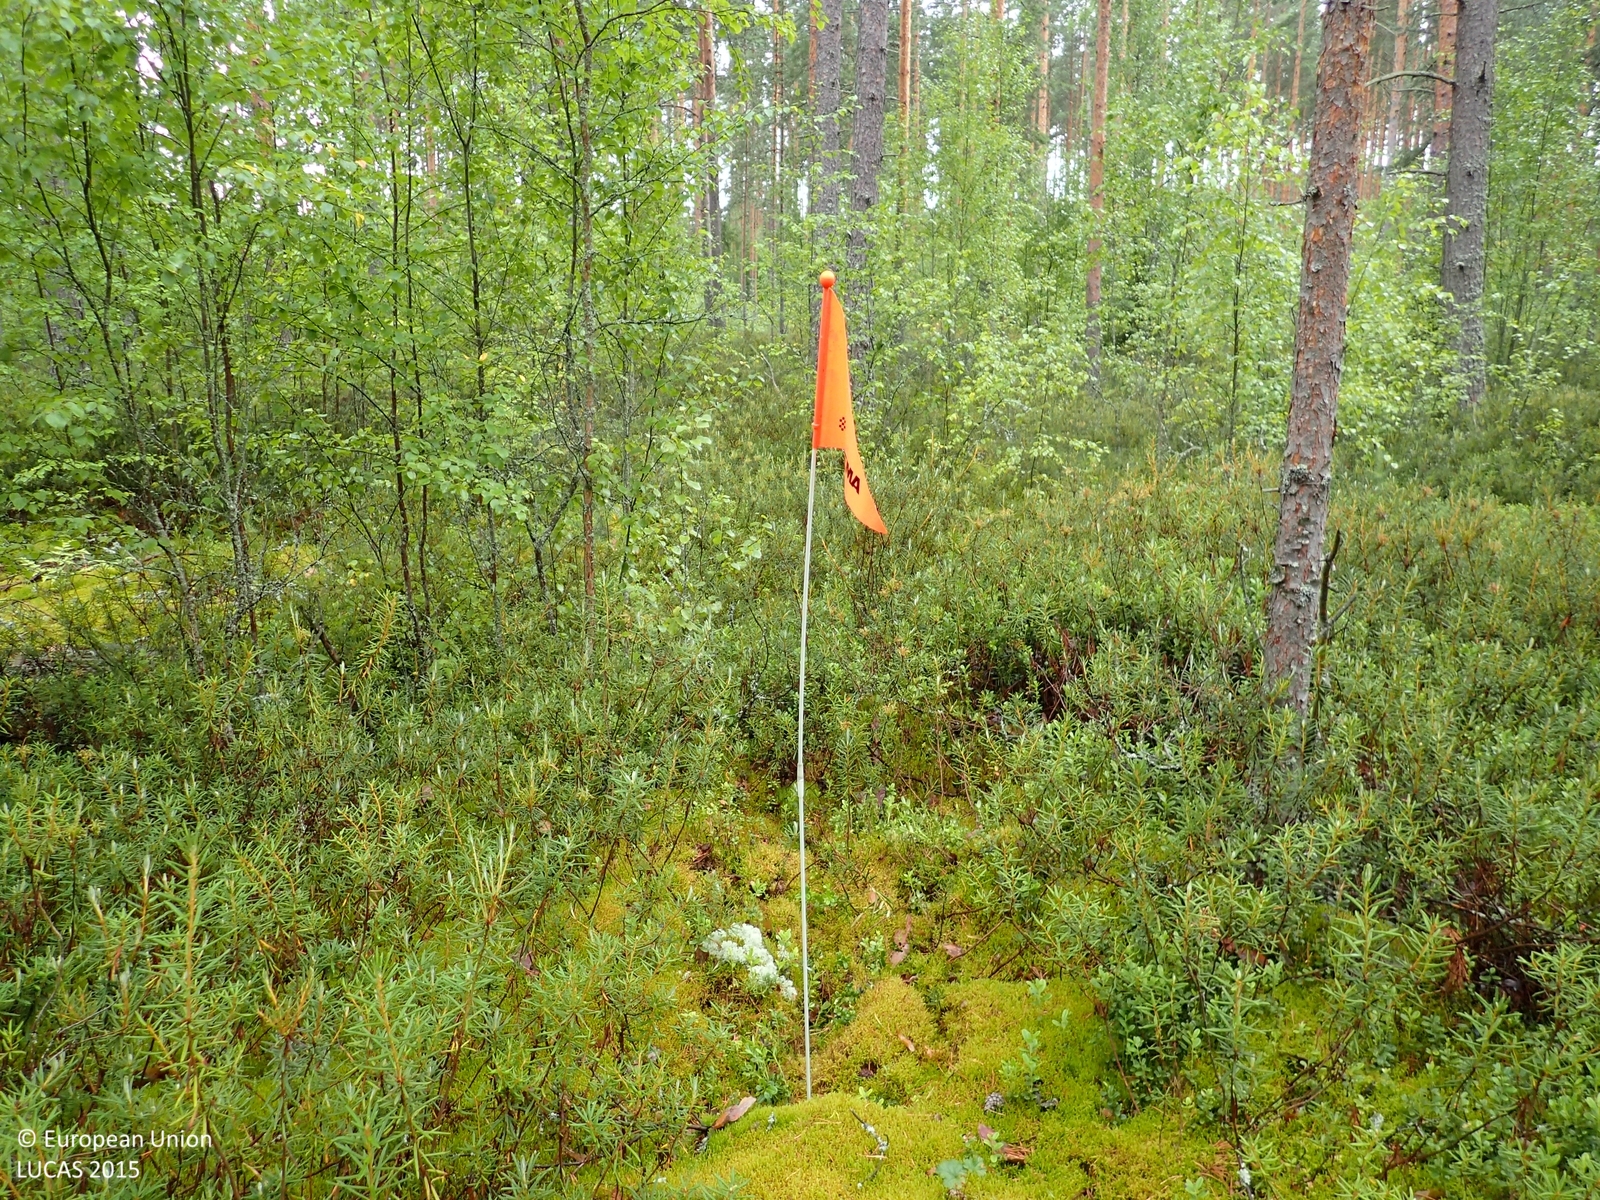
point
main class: Woodland
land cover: Pine dominated mixed woodland
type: boreal forest
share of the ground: 50 - 75 %
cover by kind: coniferous forest trees 45 %, shrubs 35 %, broadleaved forest trees 15 %, lichens and mosses 5 %
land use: Forestry
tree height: > 5 m
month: July
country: FI
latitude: 62.9852
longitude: 22.9441
